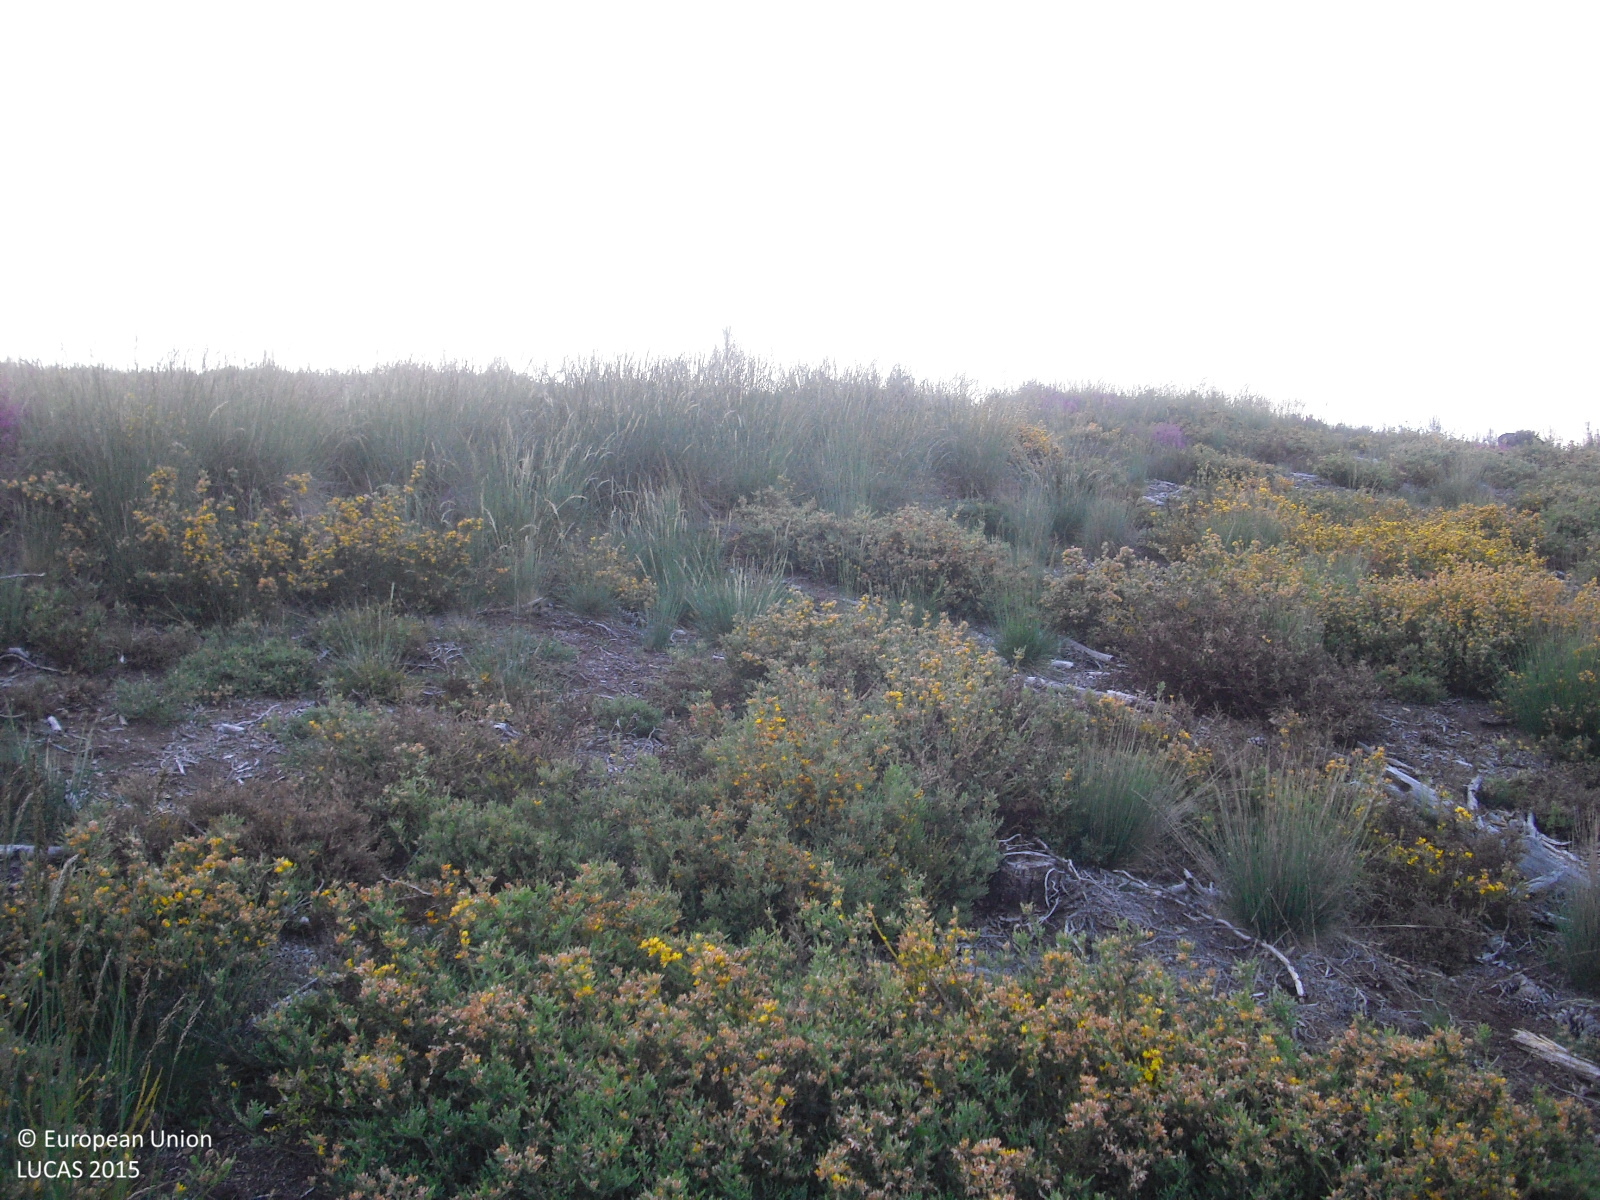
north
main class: Shrubland
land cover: Shrubland with sparse tree cover
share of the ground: > 75 %
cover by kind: shrubs 70 %, unconsolidated bare surface 25 %, broadleaved forest trees 5 %
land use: Forestry
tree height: < 5 m
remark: Clear cut
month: May
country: ES
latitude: 42.0659
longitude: -7.5521
